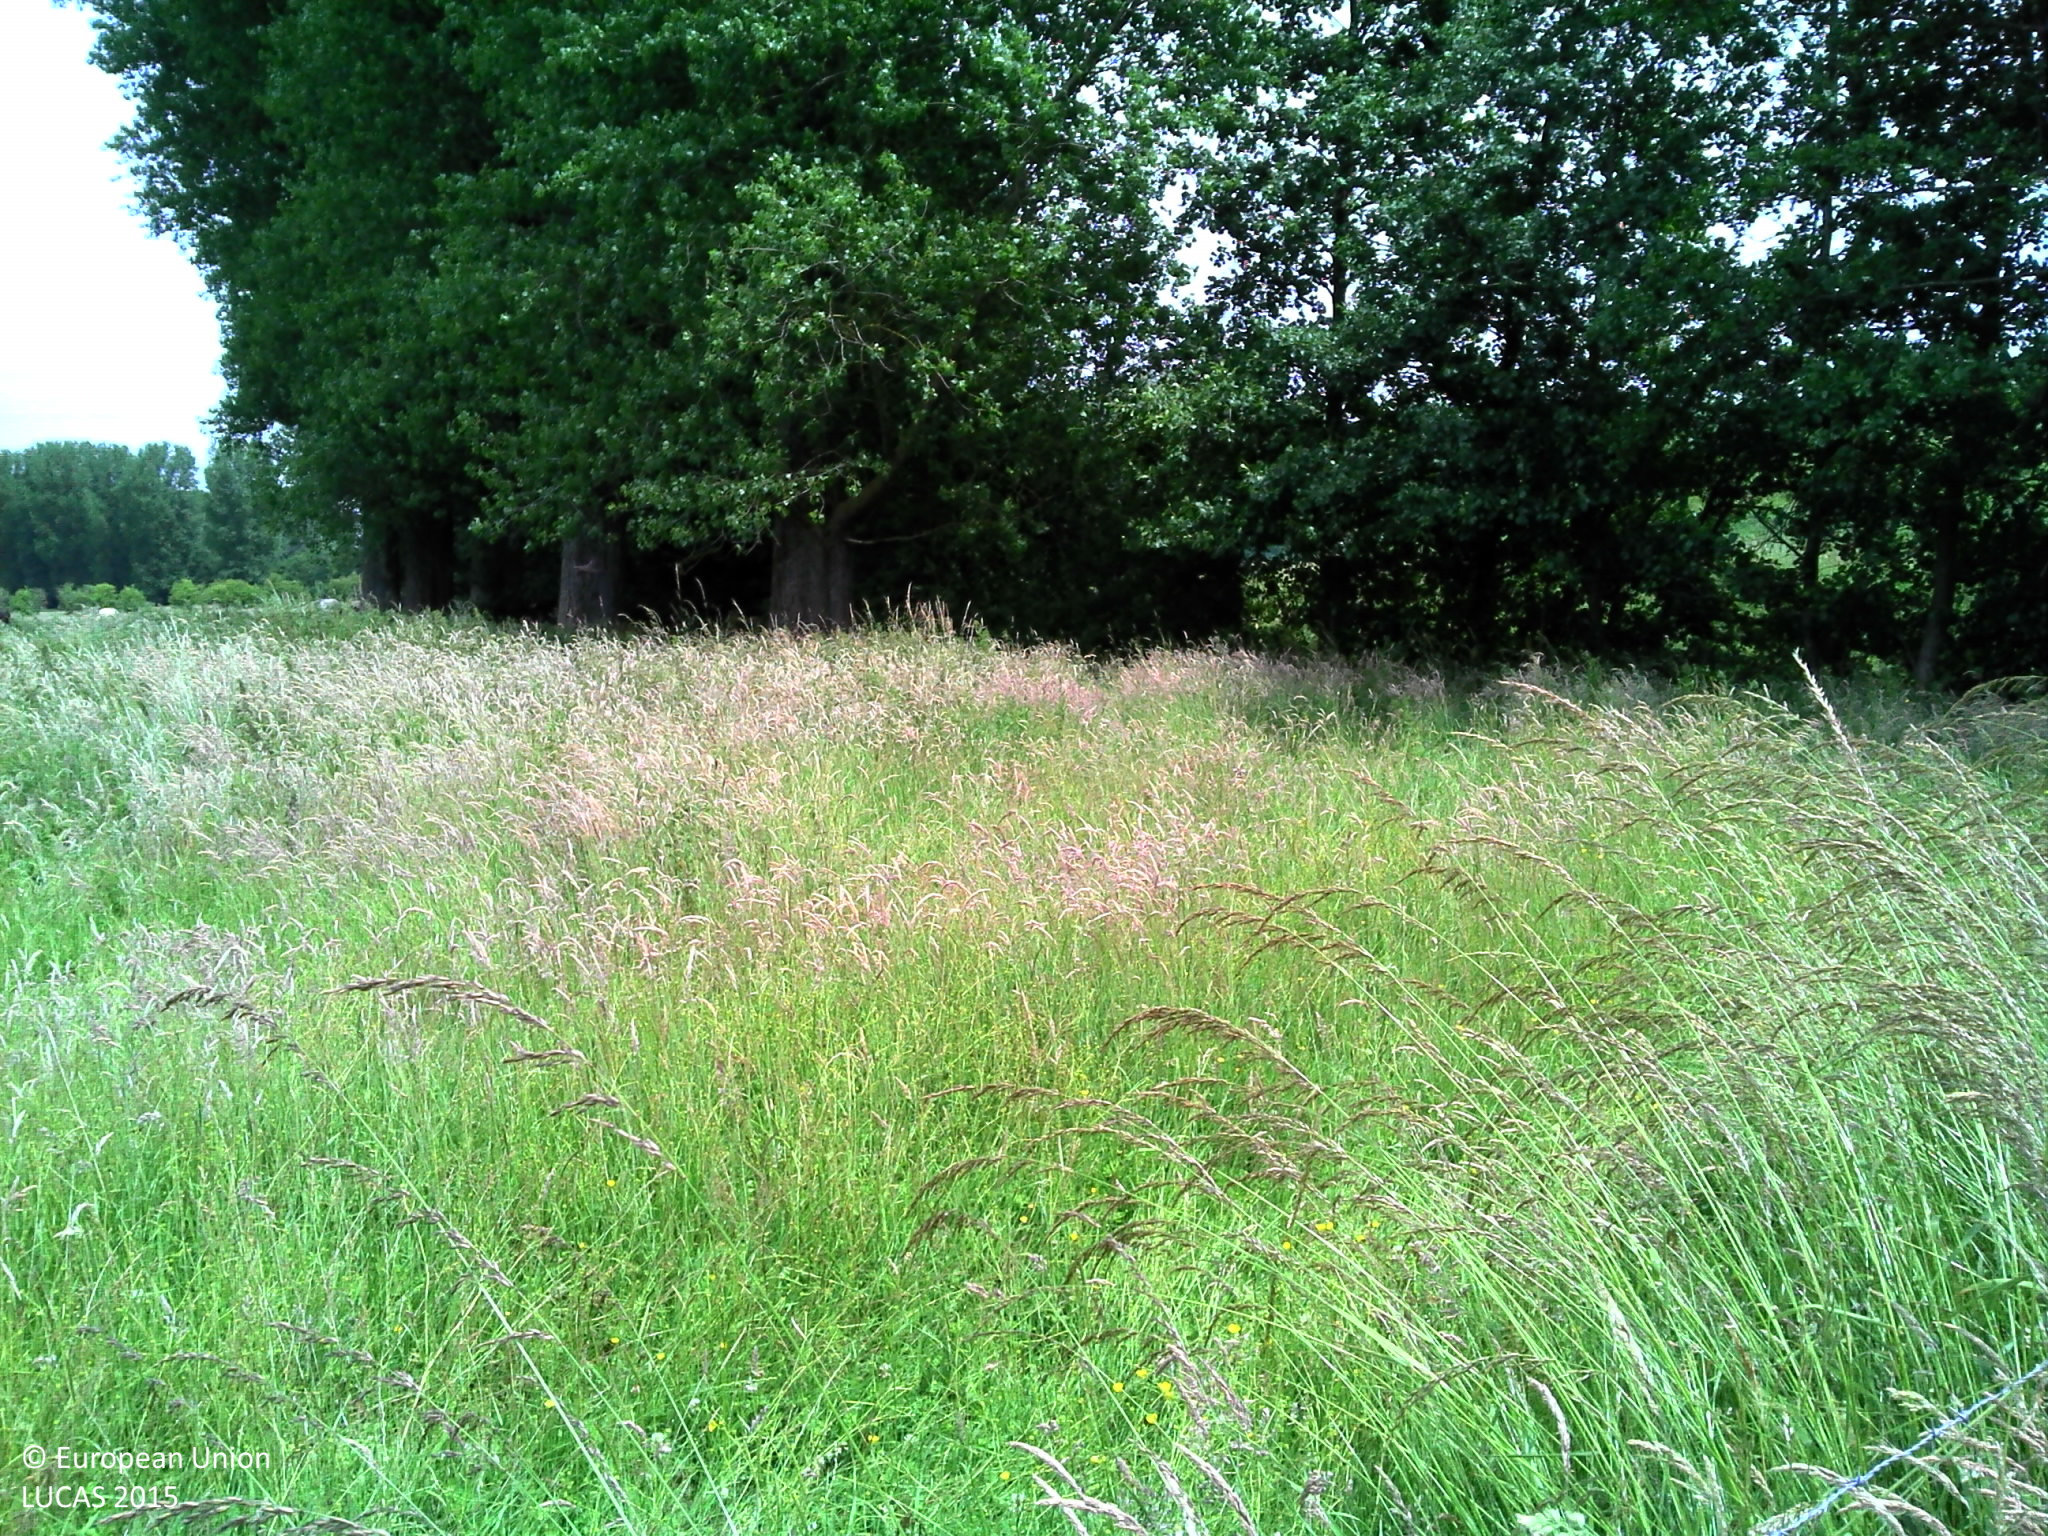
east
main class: Grassland
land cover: Grassland without tree/shrub cover
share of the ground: > 75 %
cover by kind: herbaceous plants 100 %
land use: Agriculture (excluding fallow land and kitchen gardens)
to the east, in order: Grassland without tree/shrub cover; Broadleaved woodland; Inland fresh running water; Grass margins; Paved roads, cycling and walking lanes; Spontaneously vegetated surfaces; Broadleaved woodland; Inland fresh water bodies
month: June
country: BE
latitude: 50.6459
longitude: 3.7850
